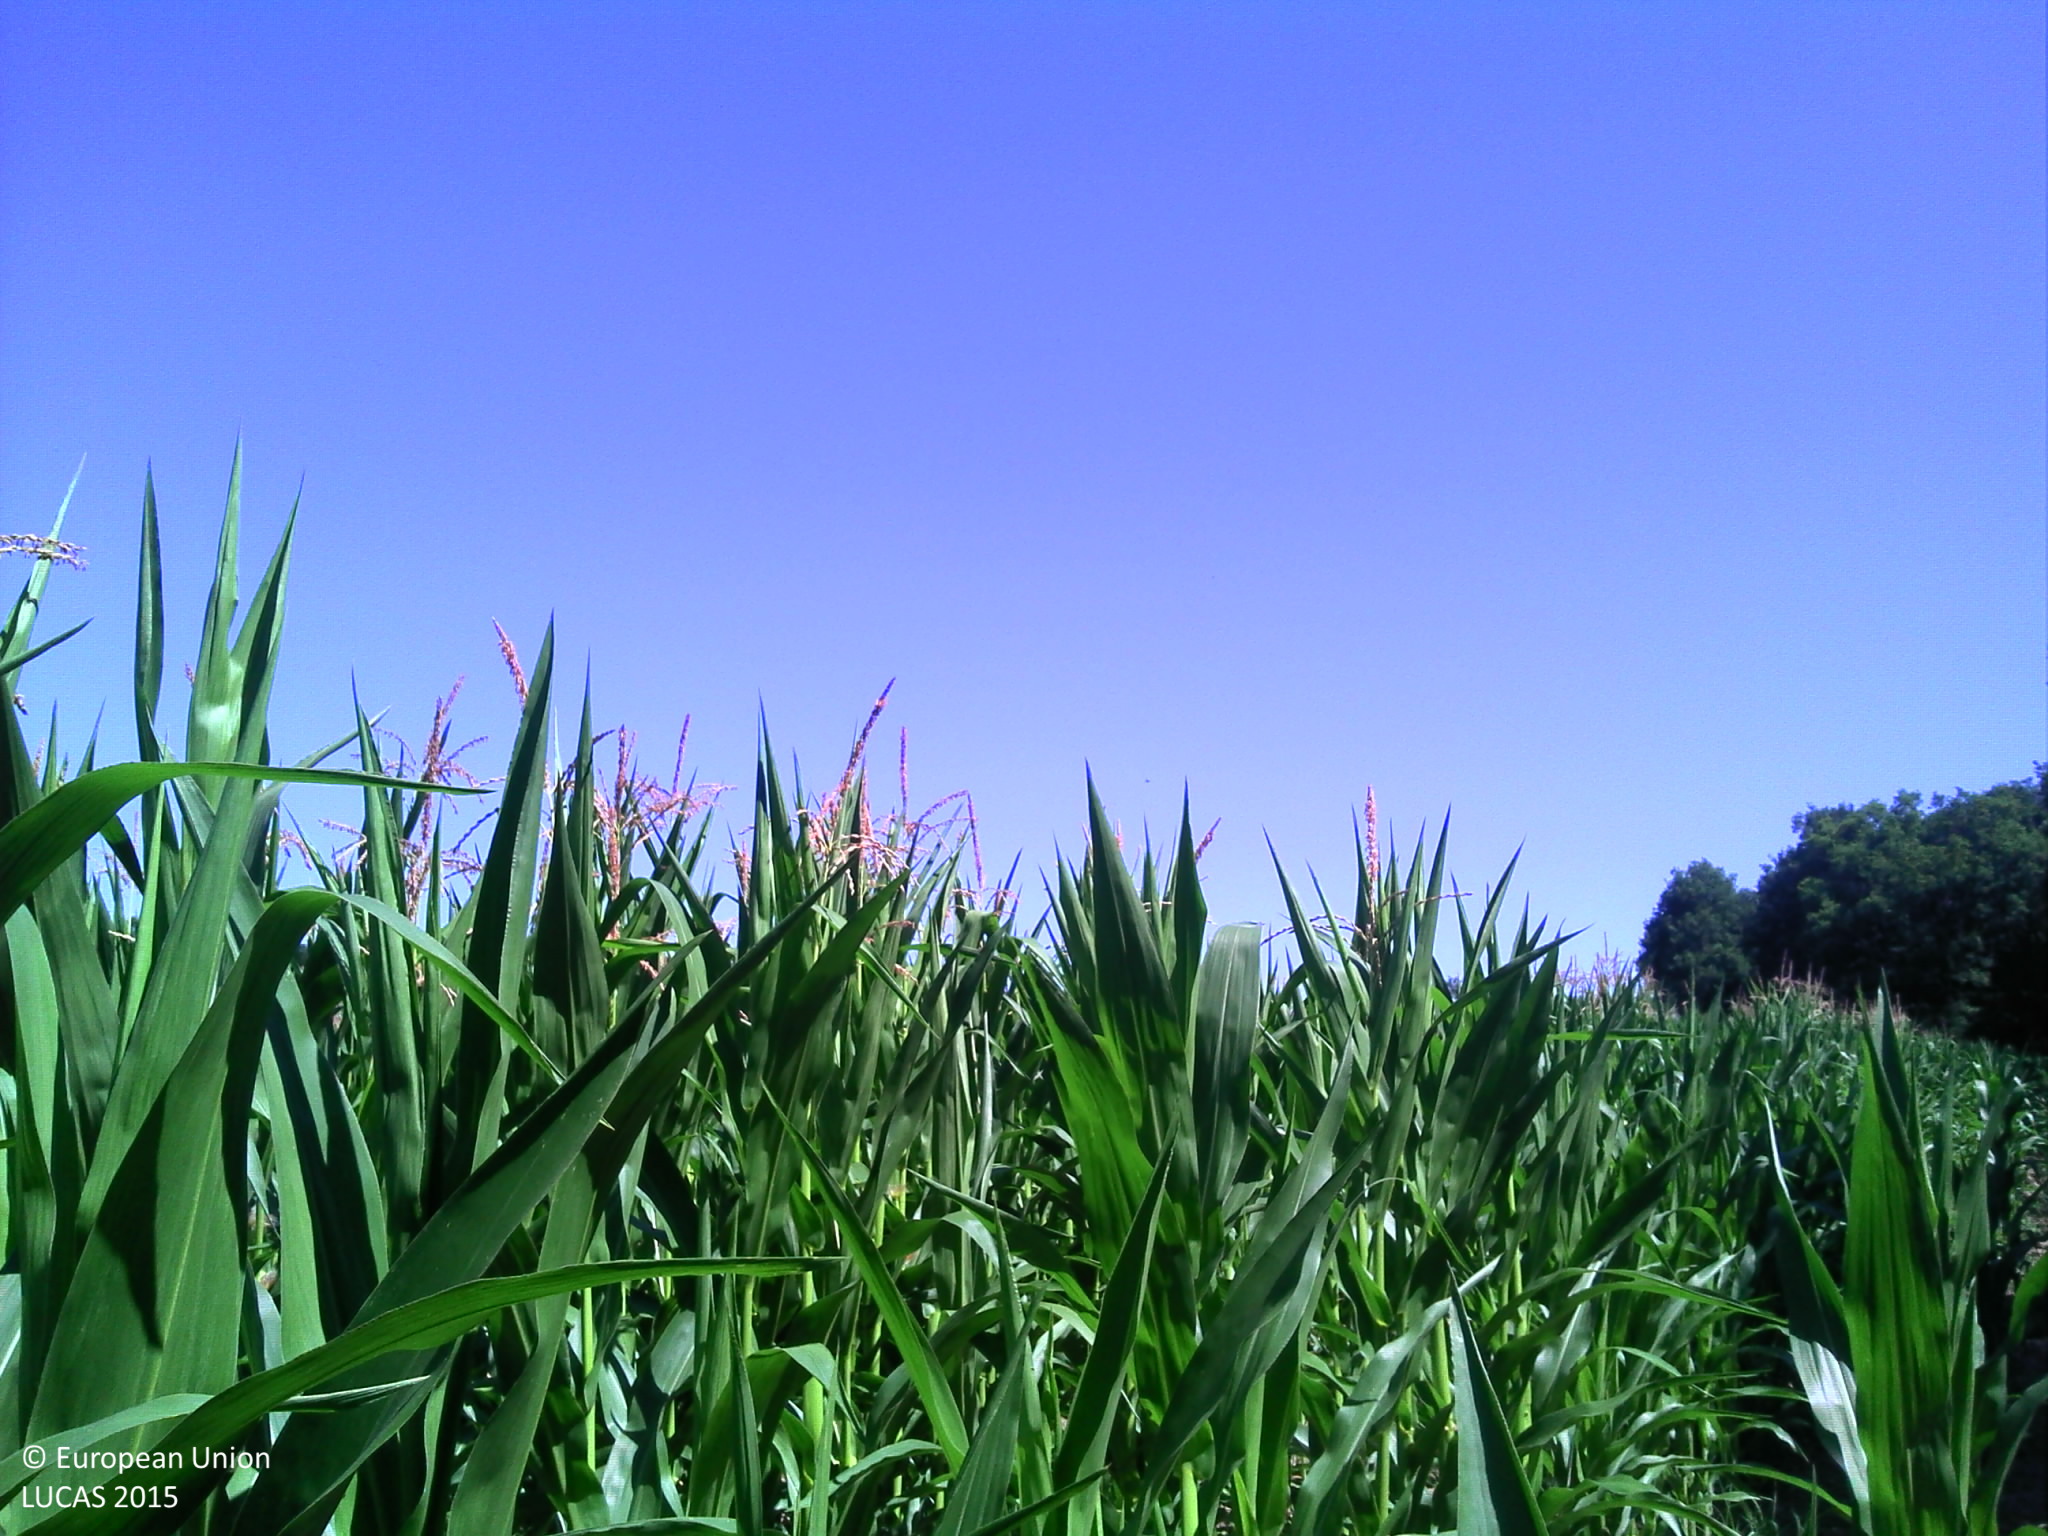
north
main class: Cropland
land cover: Maize
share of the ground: > 75 %
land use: Agriculture (excluding fallow land and kitchen gardens)
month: July
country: FR
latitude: 47.5831
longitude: 0.3639
